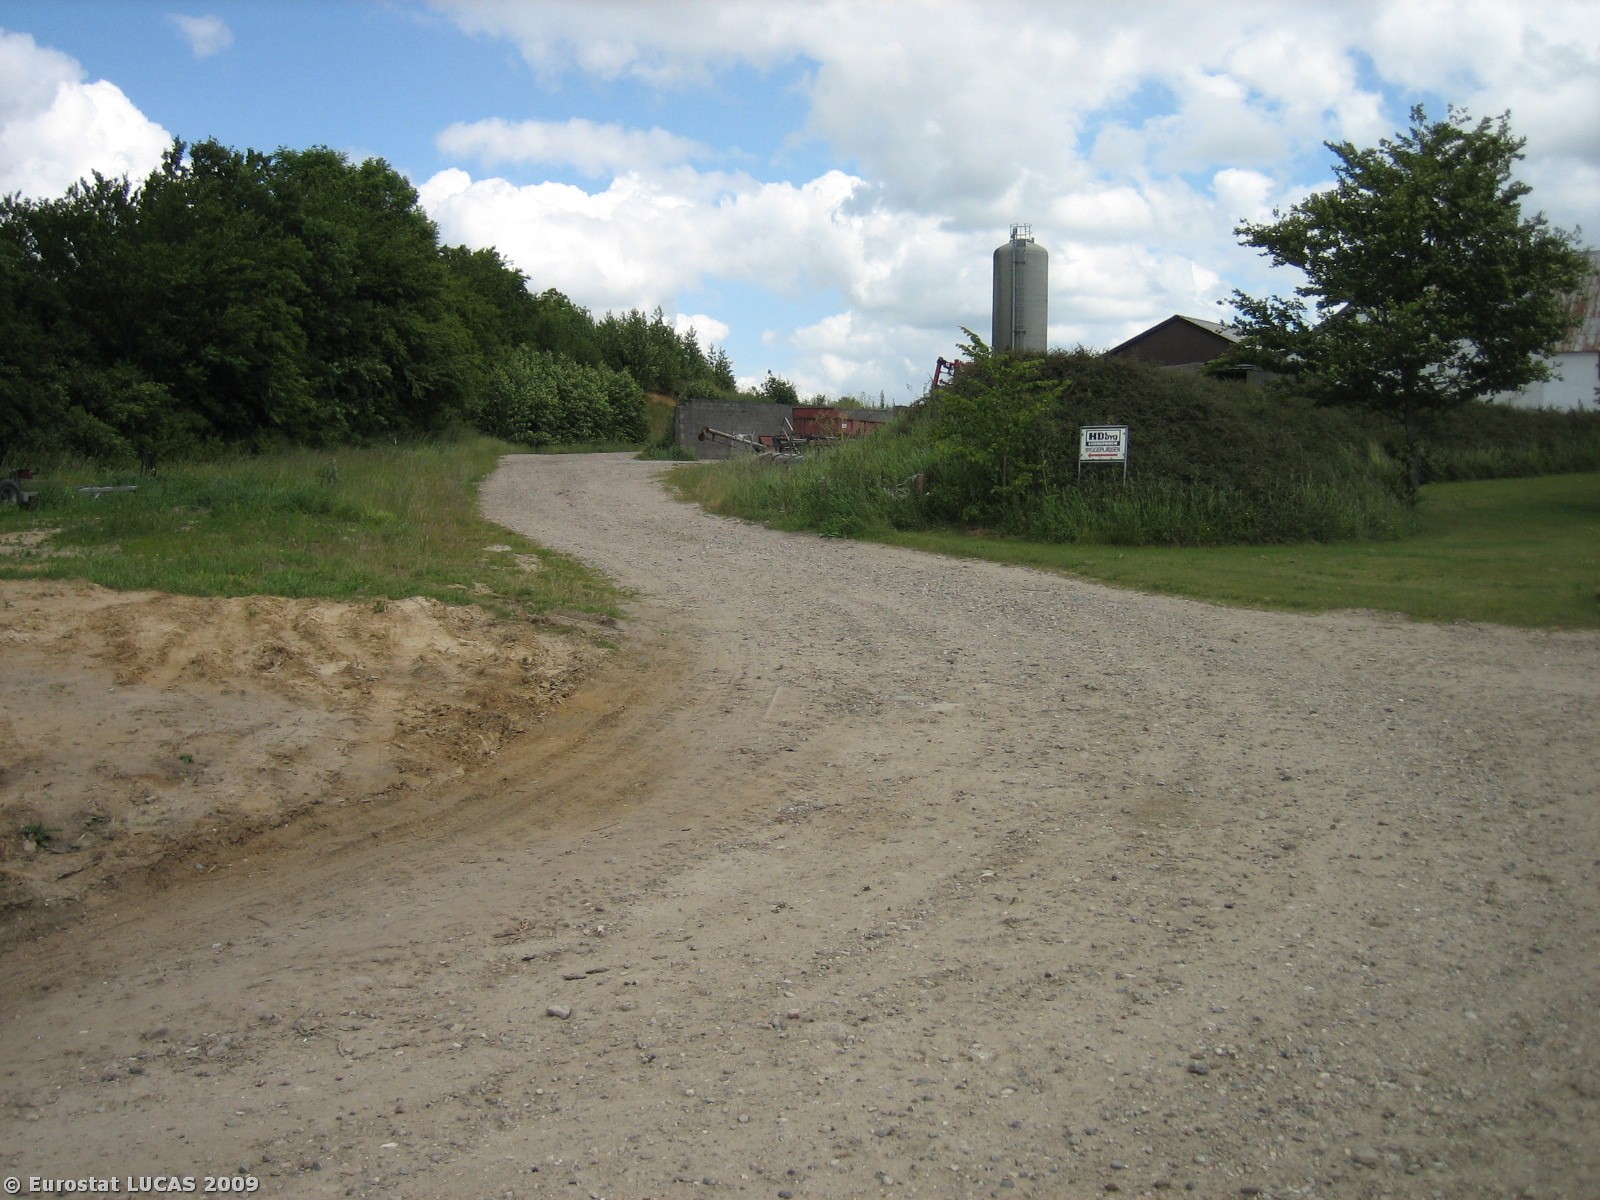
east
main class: Grassland
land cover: Grassland without tree/shrub cover
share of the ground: 10 - 25 %
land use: Agriculture (excluding fallow land and kitchen gardens)
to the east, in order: Grassland without tree/shrub cover; Fences; Tracks; Bare land; Tracks; Grassland with sparse tree/shrub cover; Artificial constructions in urban areas; Grassland without tree/shrub cover; Tracks; Grassland with sparse tree/shrub cover; Fences; Tracks; Fences; Spontaneously vegetated surfaces; Artificial constructions in urban areas; Bare land; Spontaneously vegetated surfaces
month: June
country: DK
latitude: 55.7360
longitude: 9.2204
